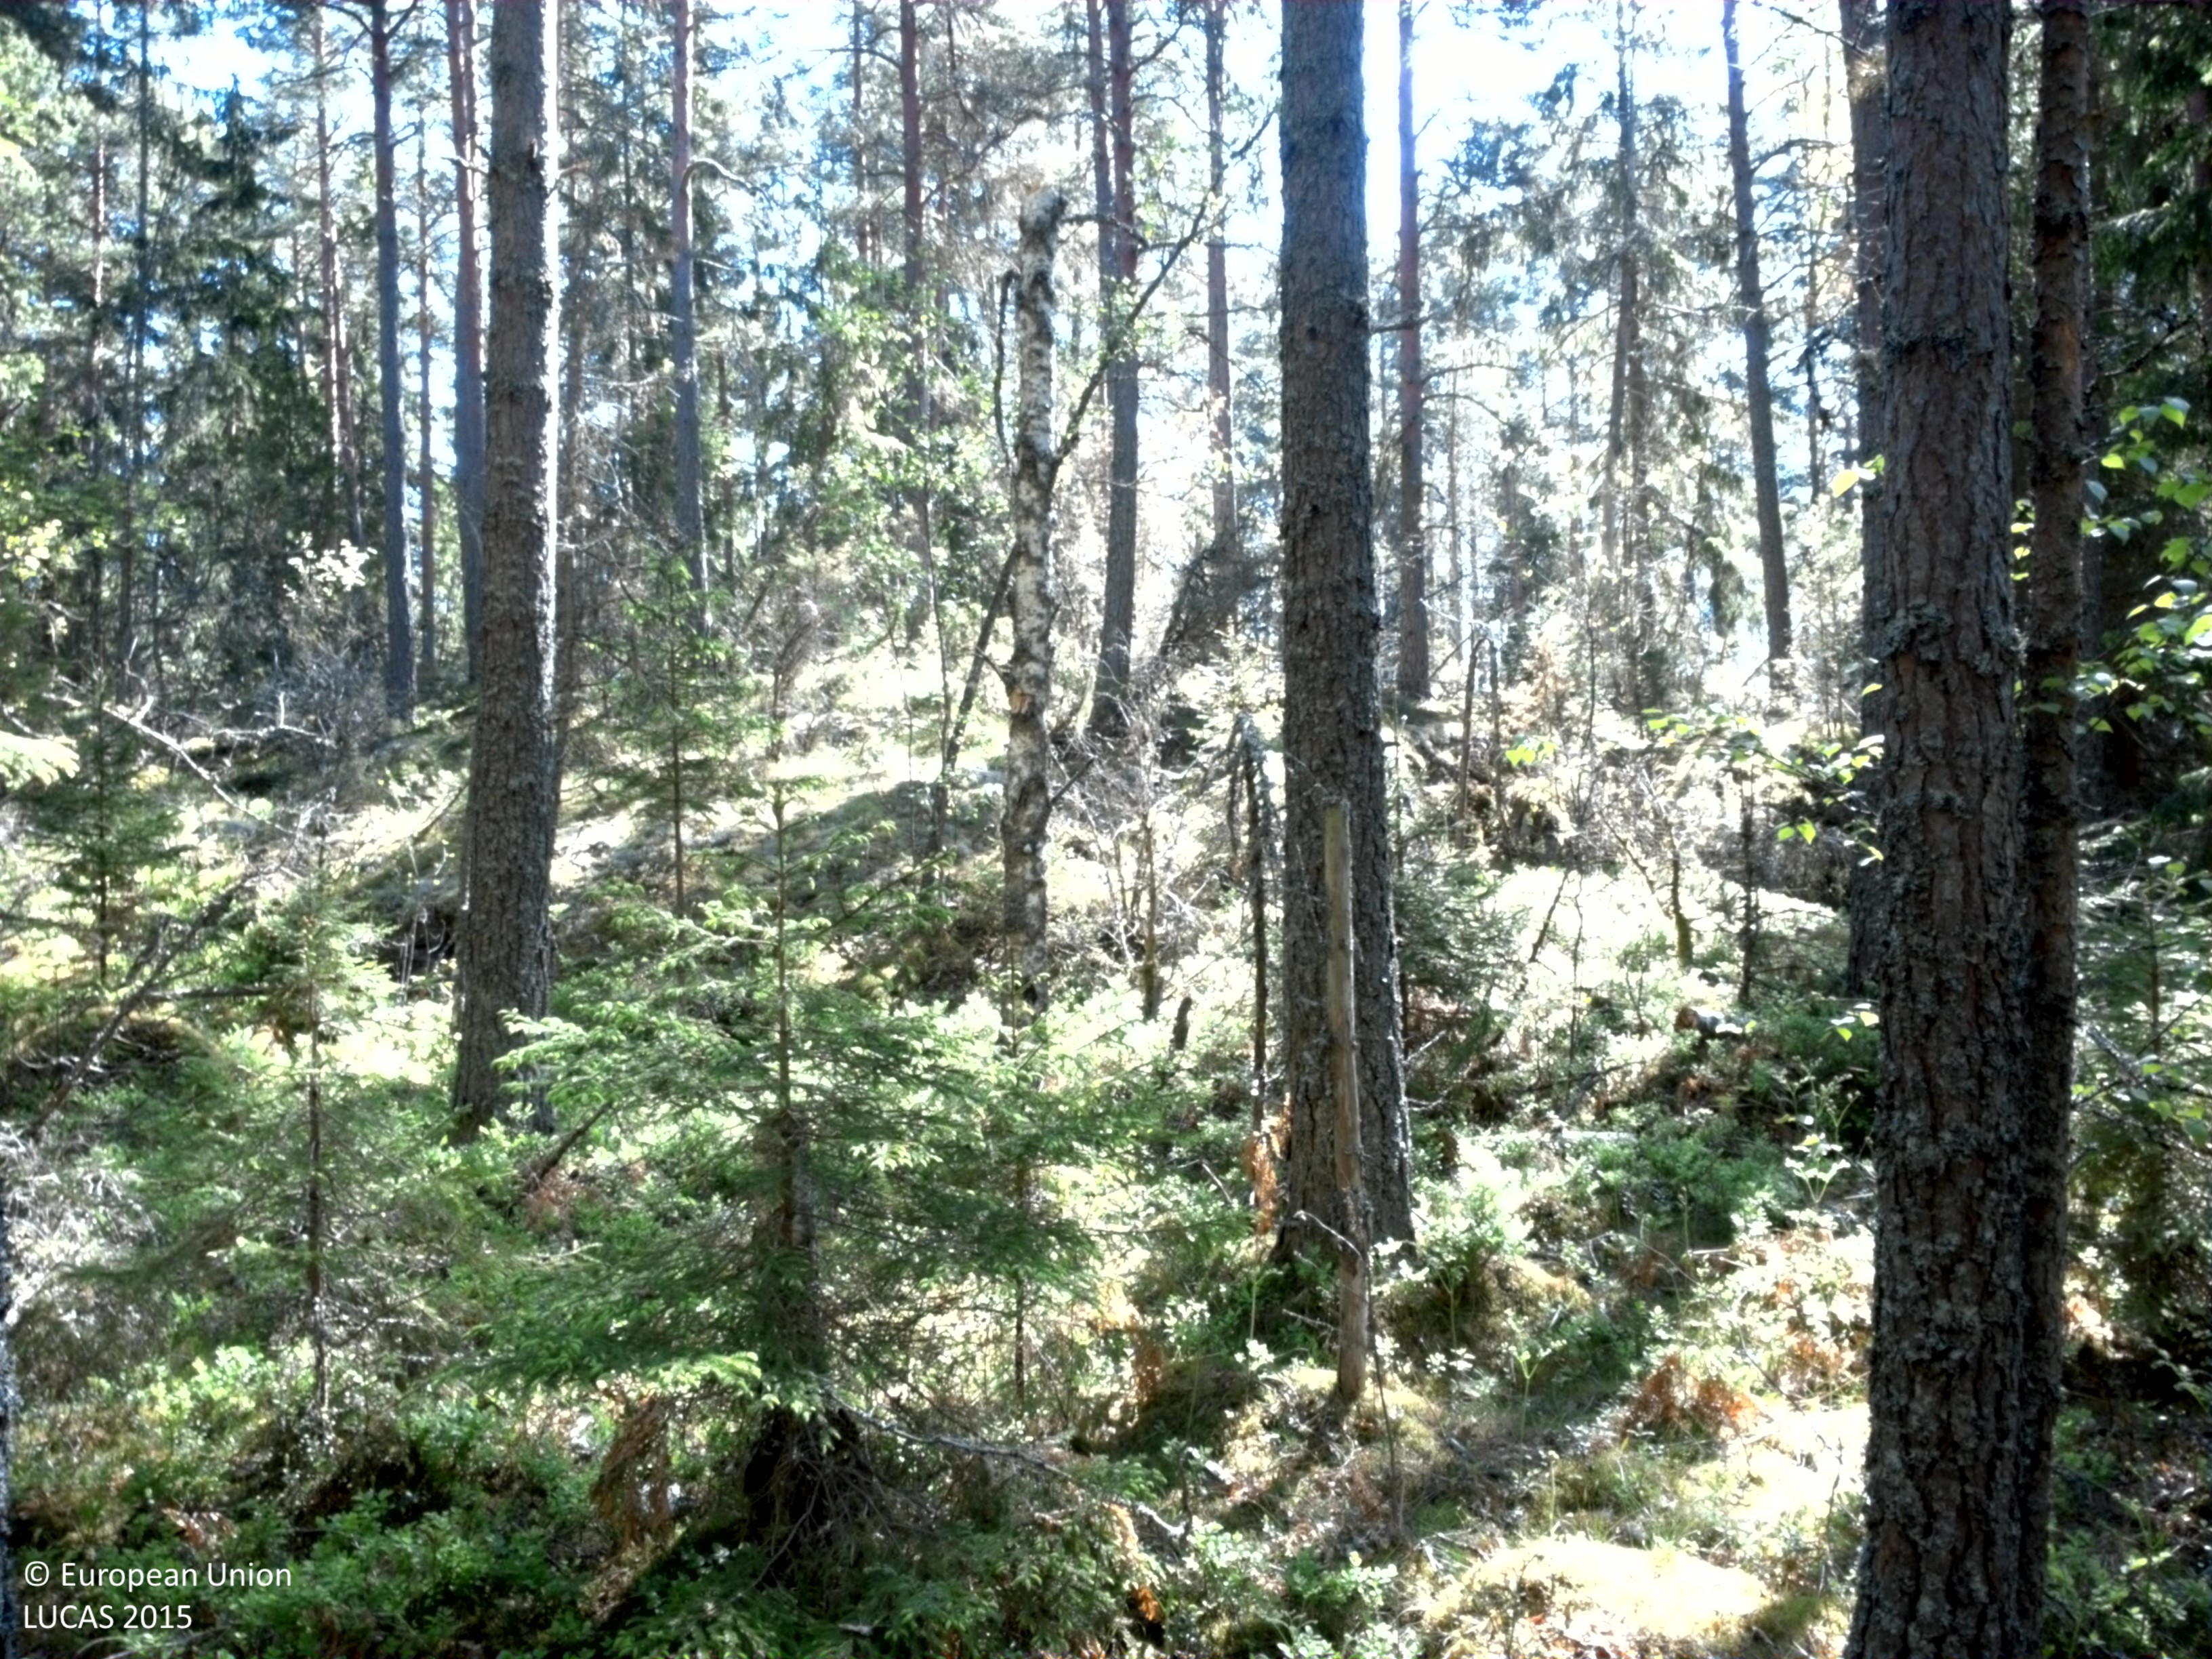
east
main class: Woodland
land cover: Pine dominated coniferous woodland
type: boreal forest
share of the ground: 50 - 75 %
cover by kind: coniferous forest trees 50 %, broadleaved forest trees 15 %, lichens and mosses 15 %, shrubs 10 %, herbaceous plants 10 %
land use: Forestry
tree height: > 5 m
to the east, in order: Pine dominated coniferous woodland; Tracks; Pine dominated coniferous woodland; Shrubland with sparse tree cover; Grassland with sparse tree/shrub cover
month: May
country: SE
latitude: 57.3819
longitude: 16.0028
